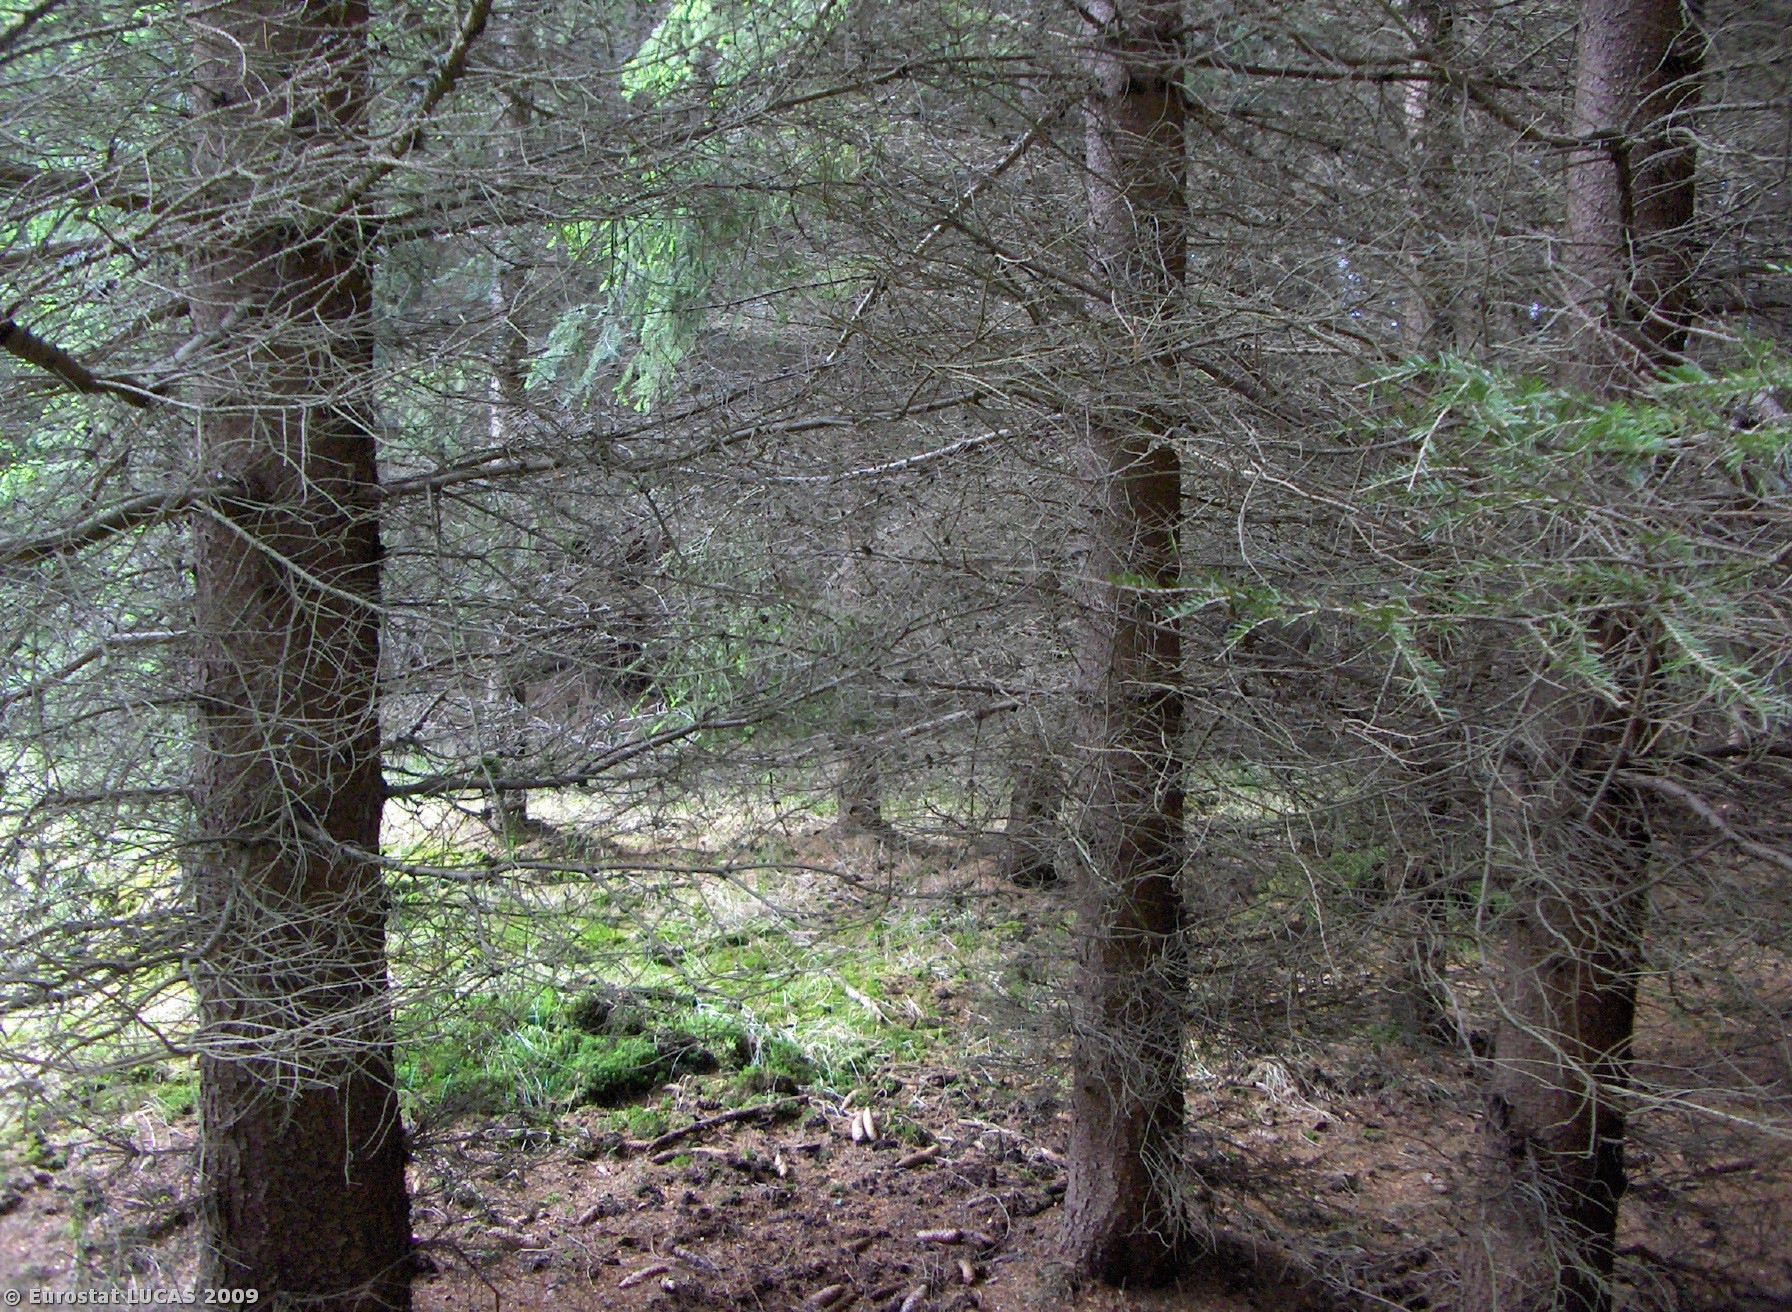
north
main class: Woodland
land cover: Coniferous woodland
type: hemiboreal forest and nemoral coniferous forest and mixed broadleaved-coniferous forest
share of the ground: > 75 %
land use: Forestry
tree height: > 5 m
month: May
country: CZ
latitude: 49.2817
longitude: 14.5792
